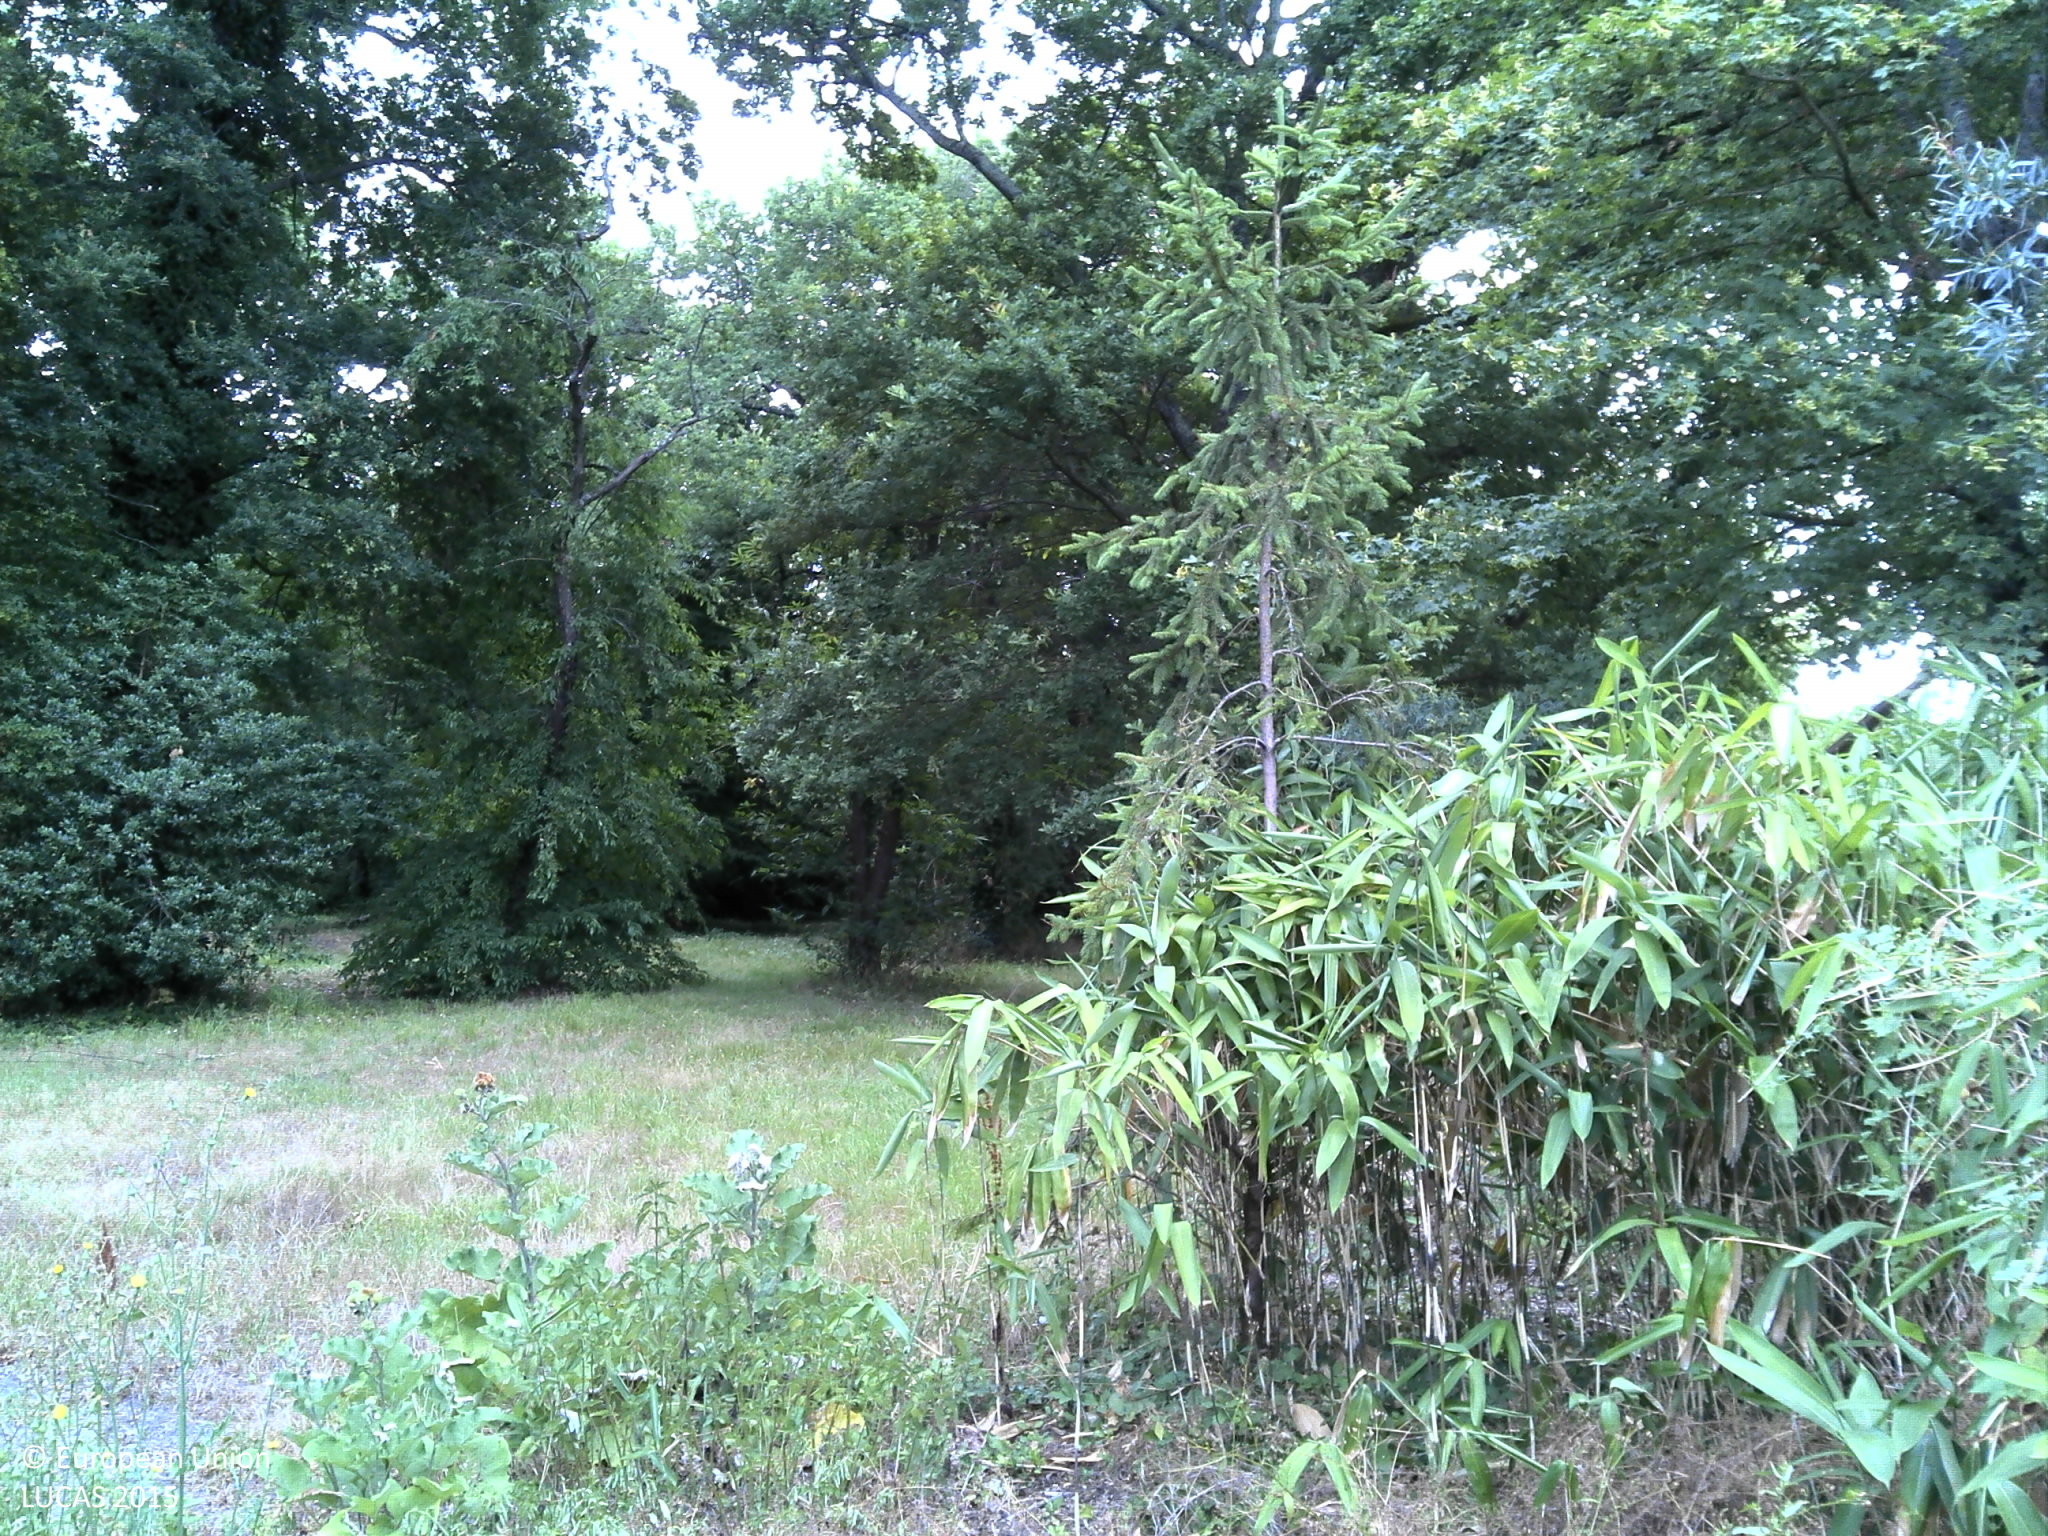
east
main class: Woodland
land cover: Broadleaved woodland
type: acidophilous oak and oak-birch forest
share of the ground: > 75 %
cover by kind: broadleaved forest trees 50 %, herbaceous plants 50 %
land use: Community services
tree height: > 5 m
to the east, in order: Broadleaved woodland; Fences; Paved roads, cycling and walking lanes; Dry stone walls; Broadleaved woodland; Fences; Artificial constructions in urban areas
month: July
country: FR
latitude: 44.8718
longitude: -0.6647
